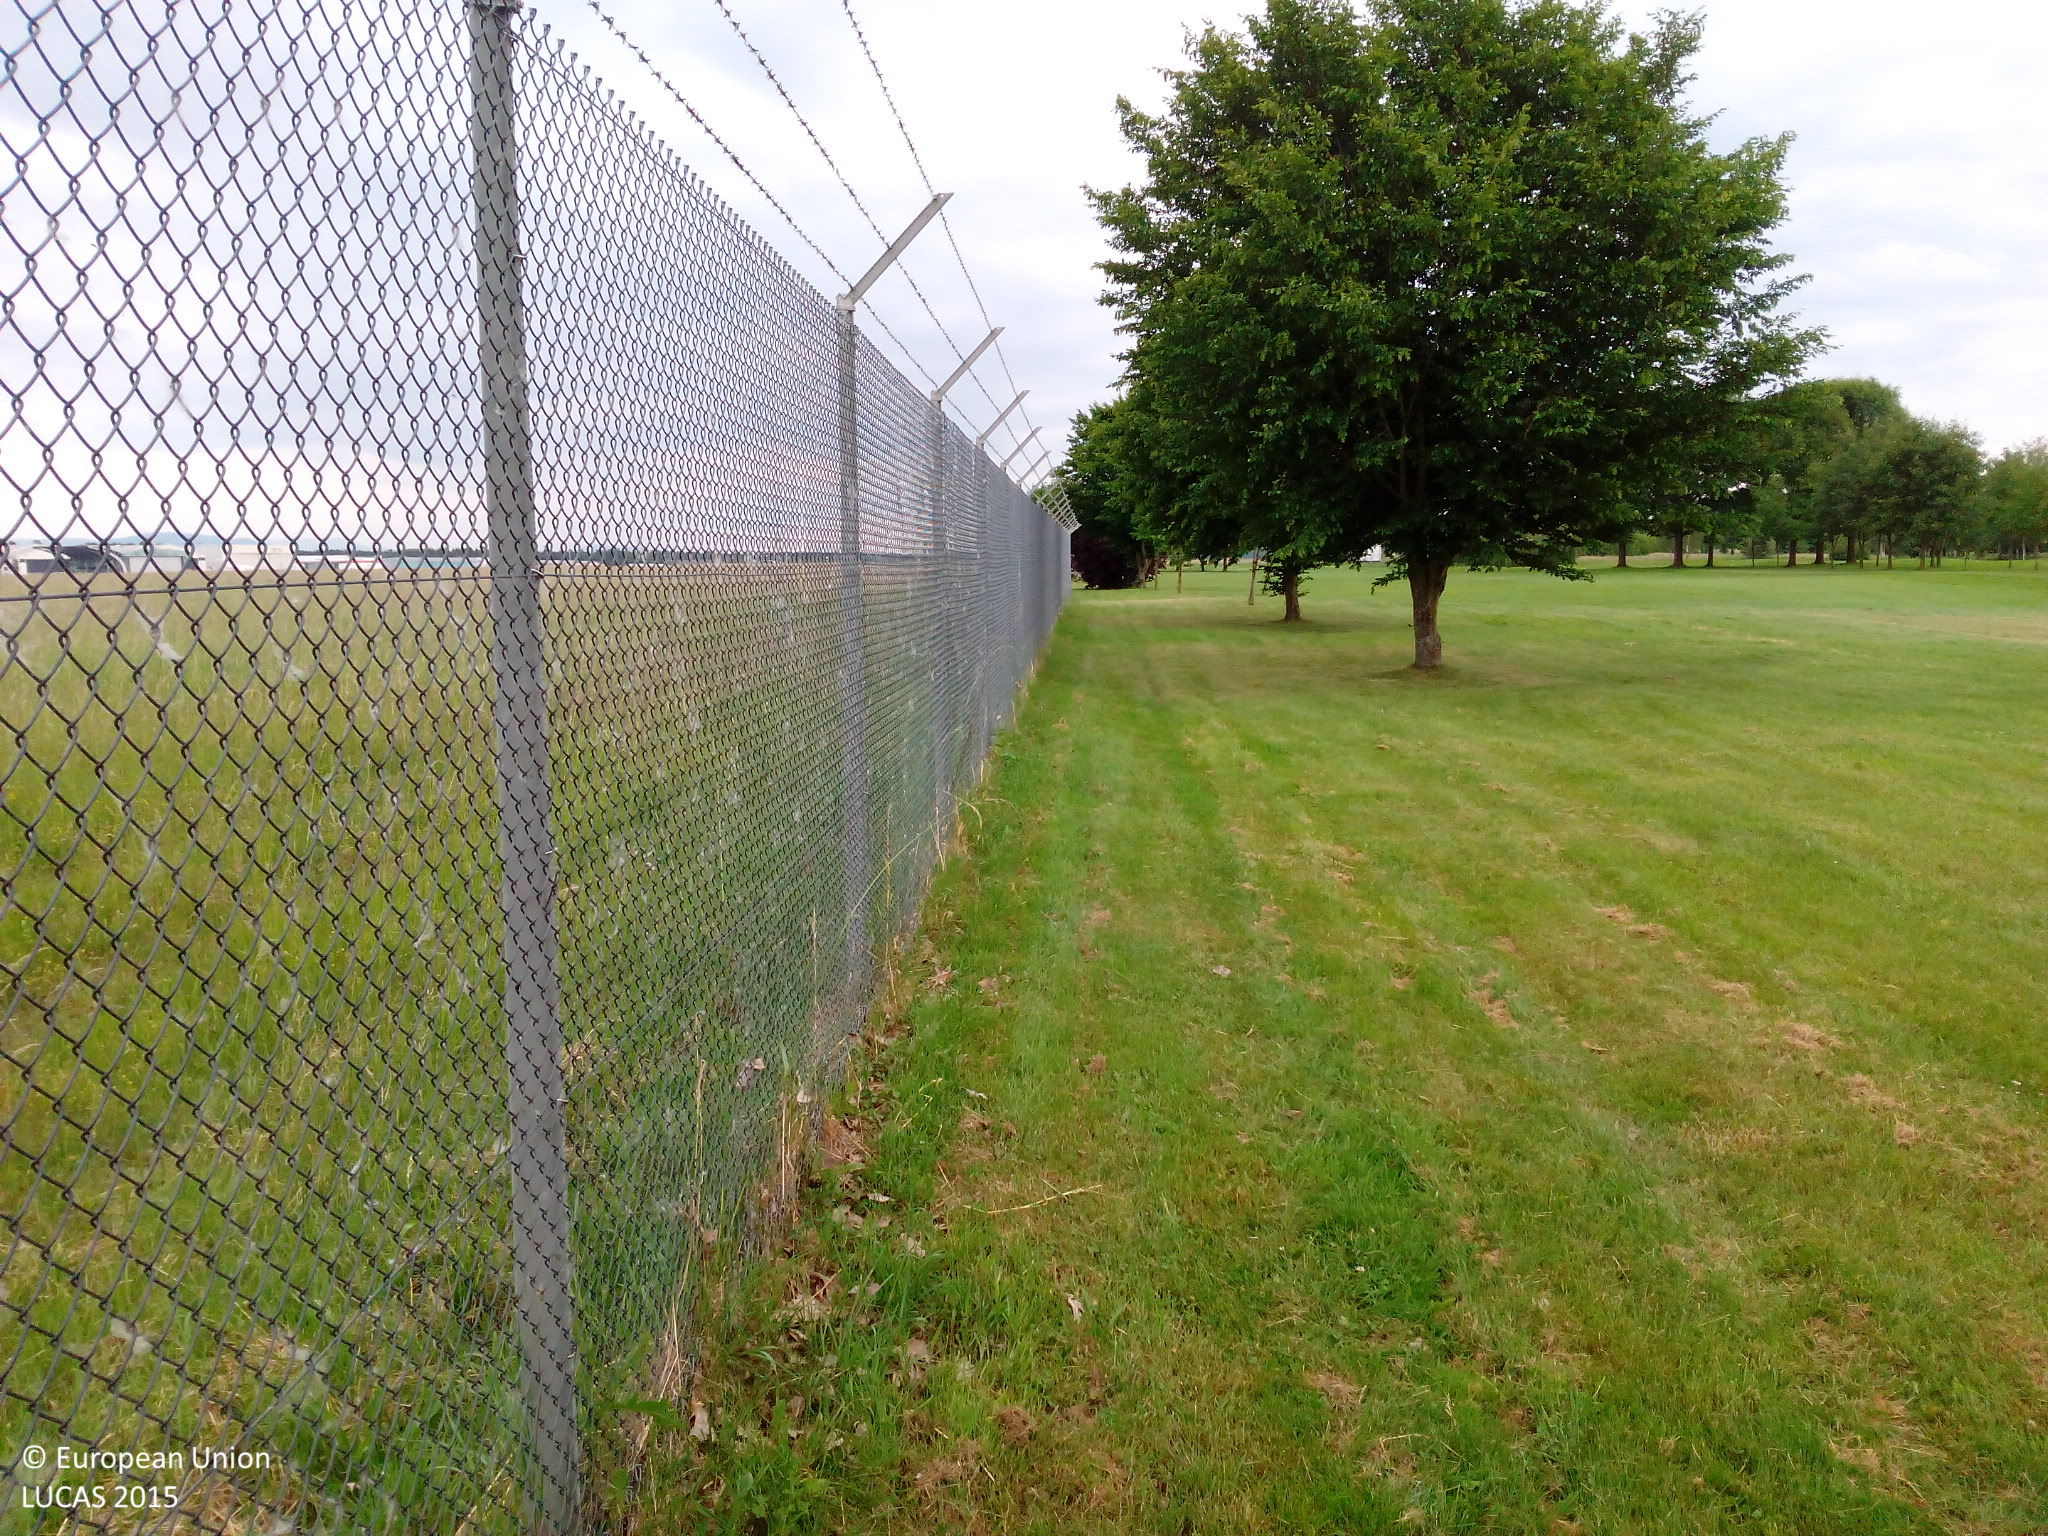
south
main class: Grassland
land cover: Grassland without tree/shrub cover
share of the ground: > 75 %
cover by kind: herbaceous plants 95 %, consolidated bare surface 5 %
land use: Air transport
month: May
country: DE
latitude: 48.7828
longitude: 8.0817
